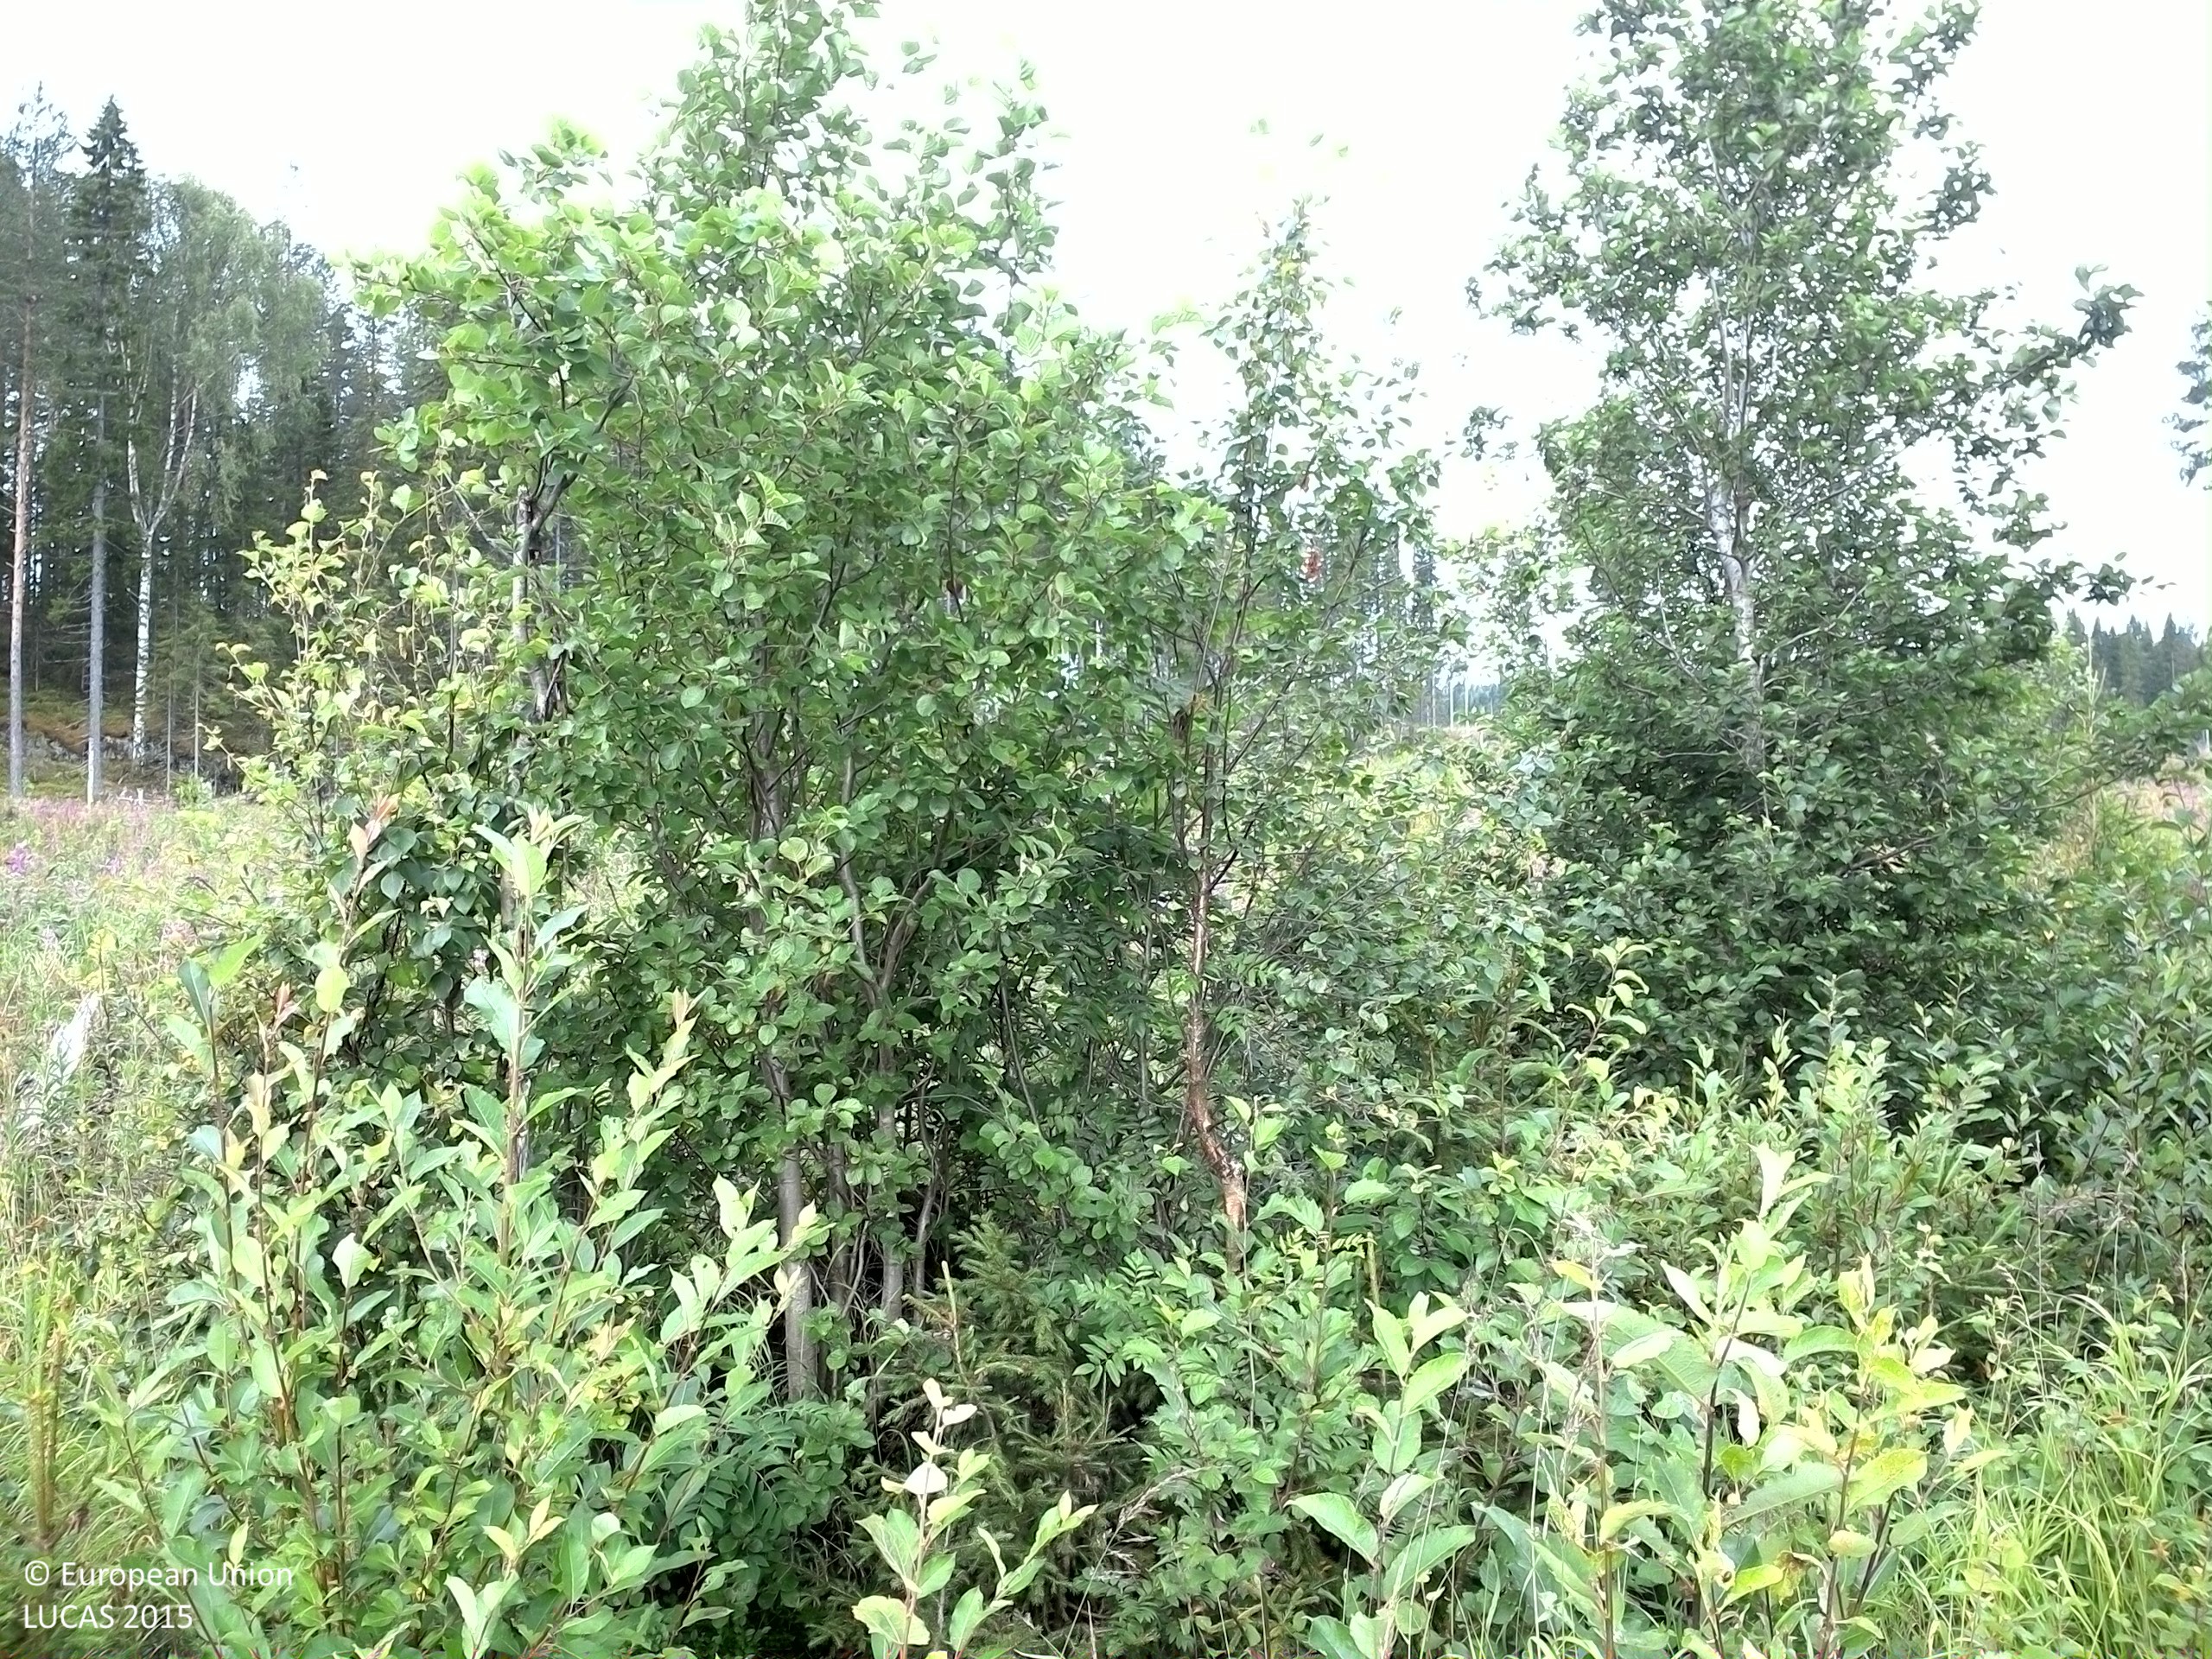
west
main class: Artificial land
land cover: Non built-up linear features
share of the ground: > 75 %
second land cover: Spontaneously vegetated surfaces
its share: 25 - 50 %
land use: Road transport
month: August
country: SE
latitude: 63.5879
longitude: 18.1754
